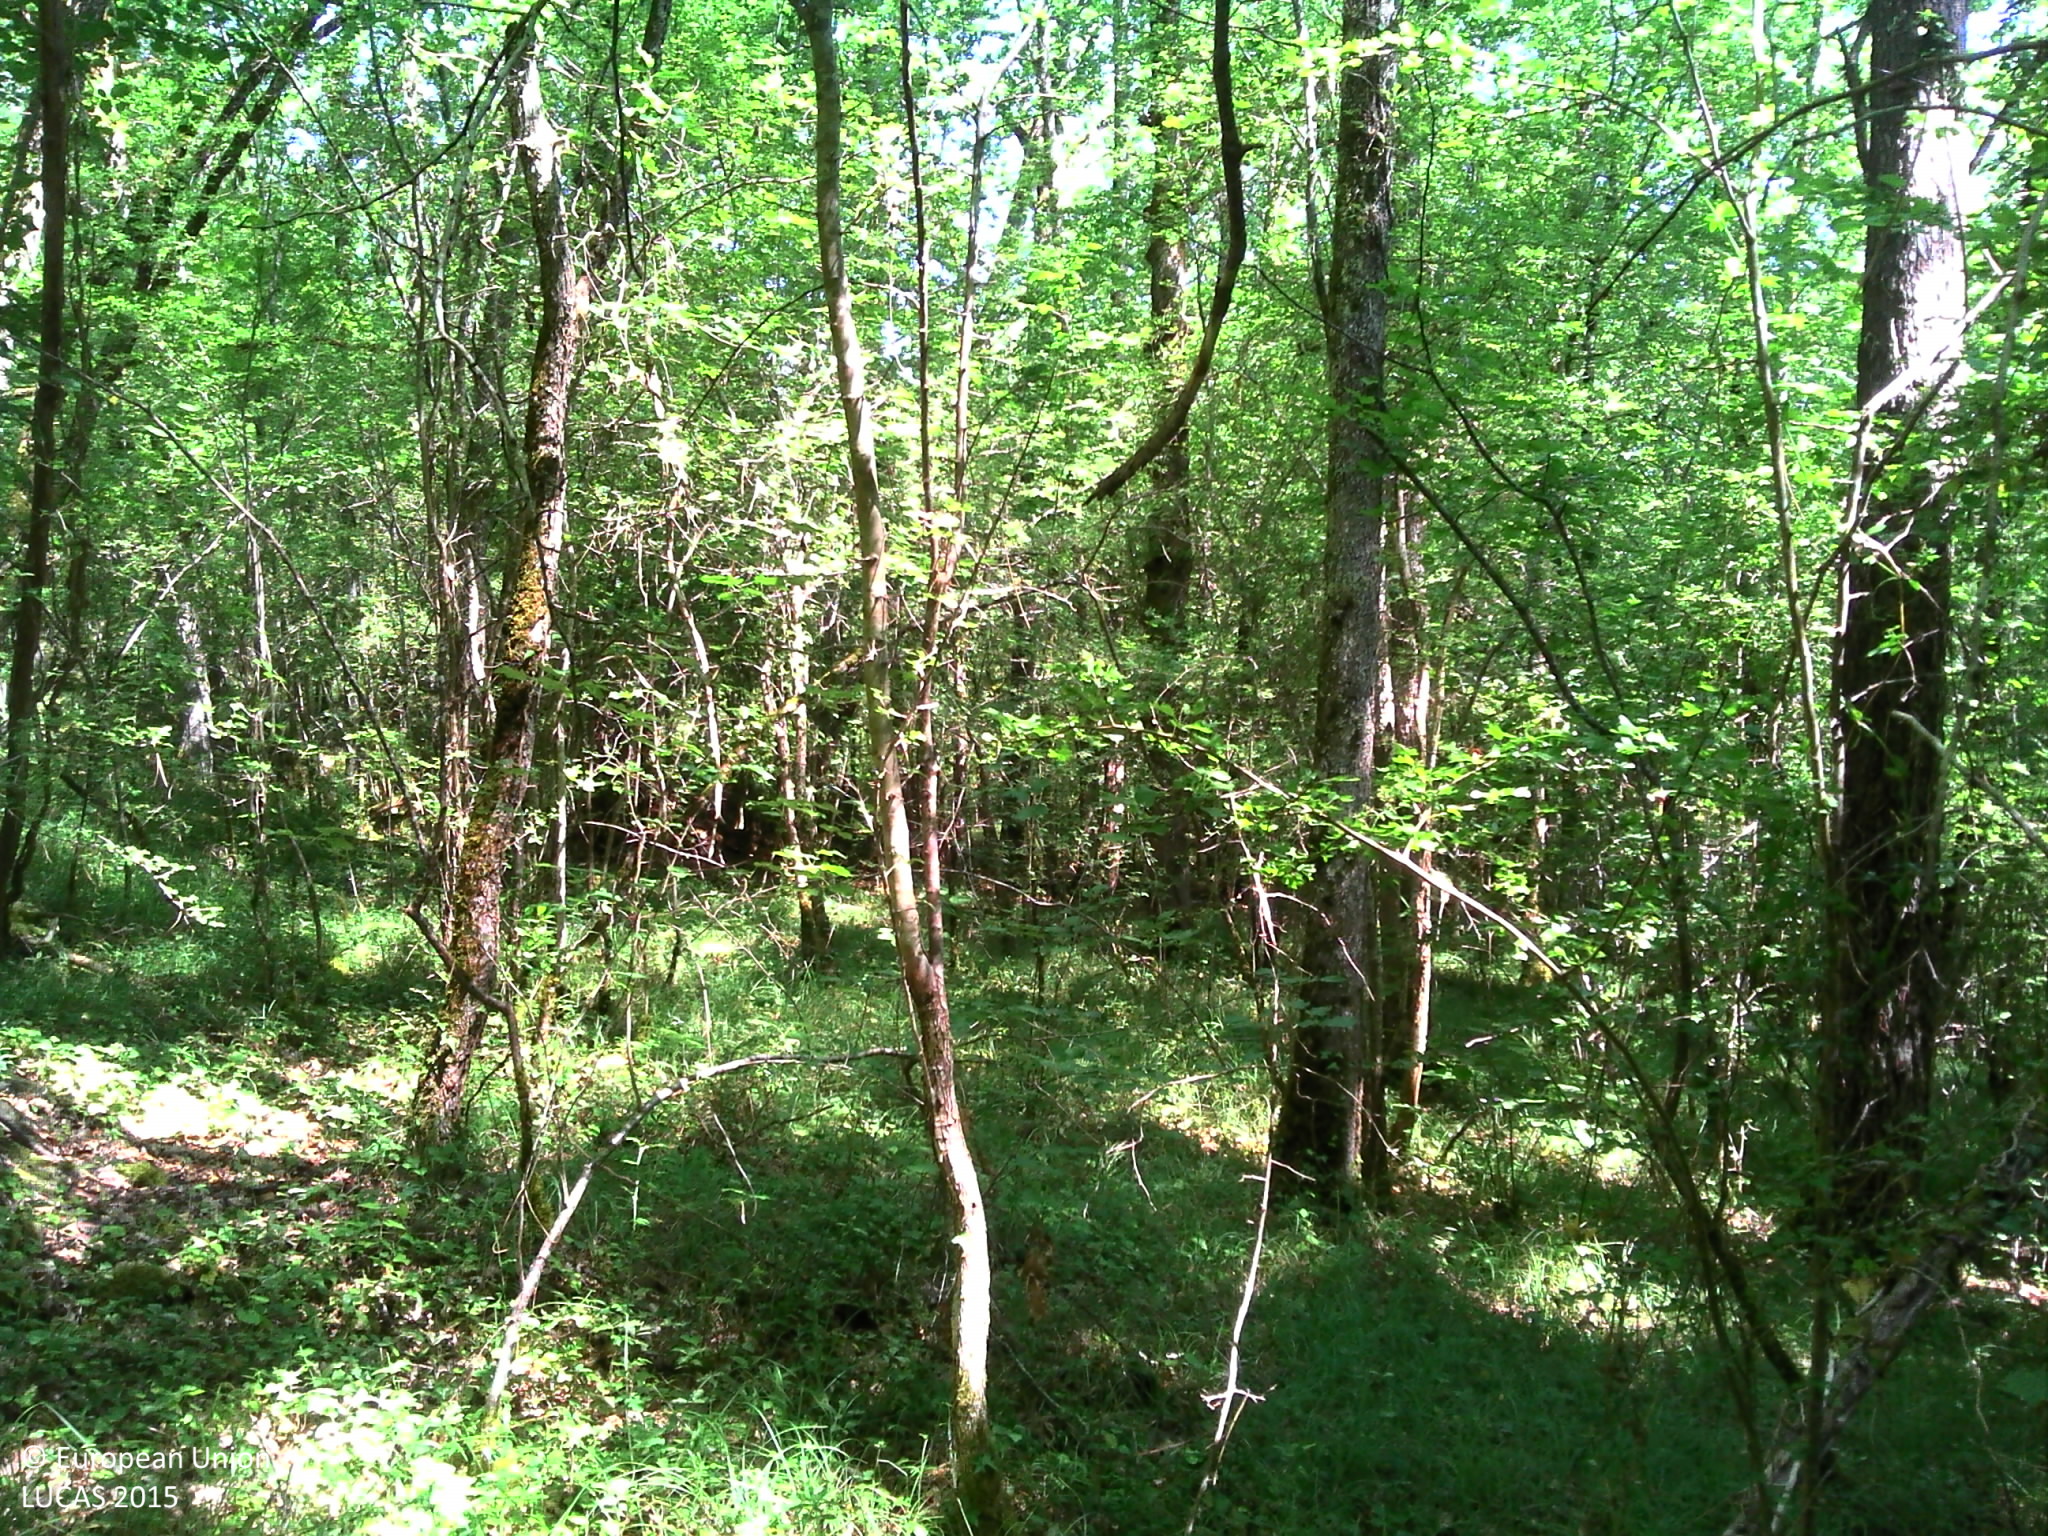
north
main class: Woodland
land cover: Broadleaved woodland
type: thermophilous deciduous forest
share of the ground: > 75 %
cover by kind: broadleaved forest trees 75 %, coniferous forest trees 10 %, herbaceous plants 10 %, lichens and mosses 5 %
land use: Forestry
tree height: > 5 m
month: June
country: FR
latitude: 44.5747
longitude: 0.9910
